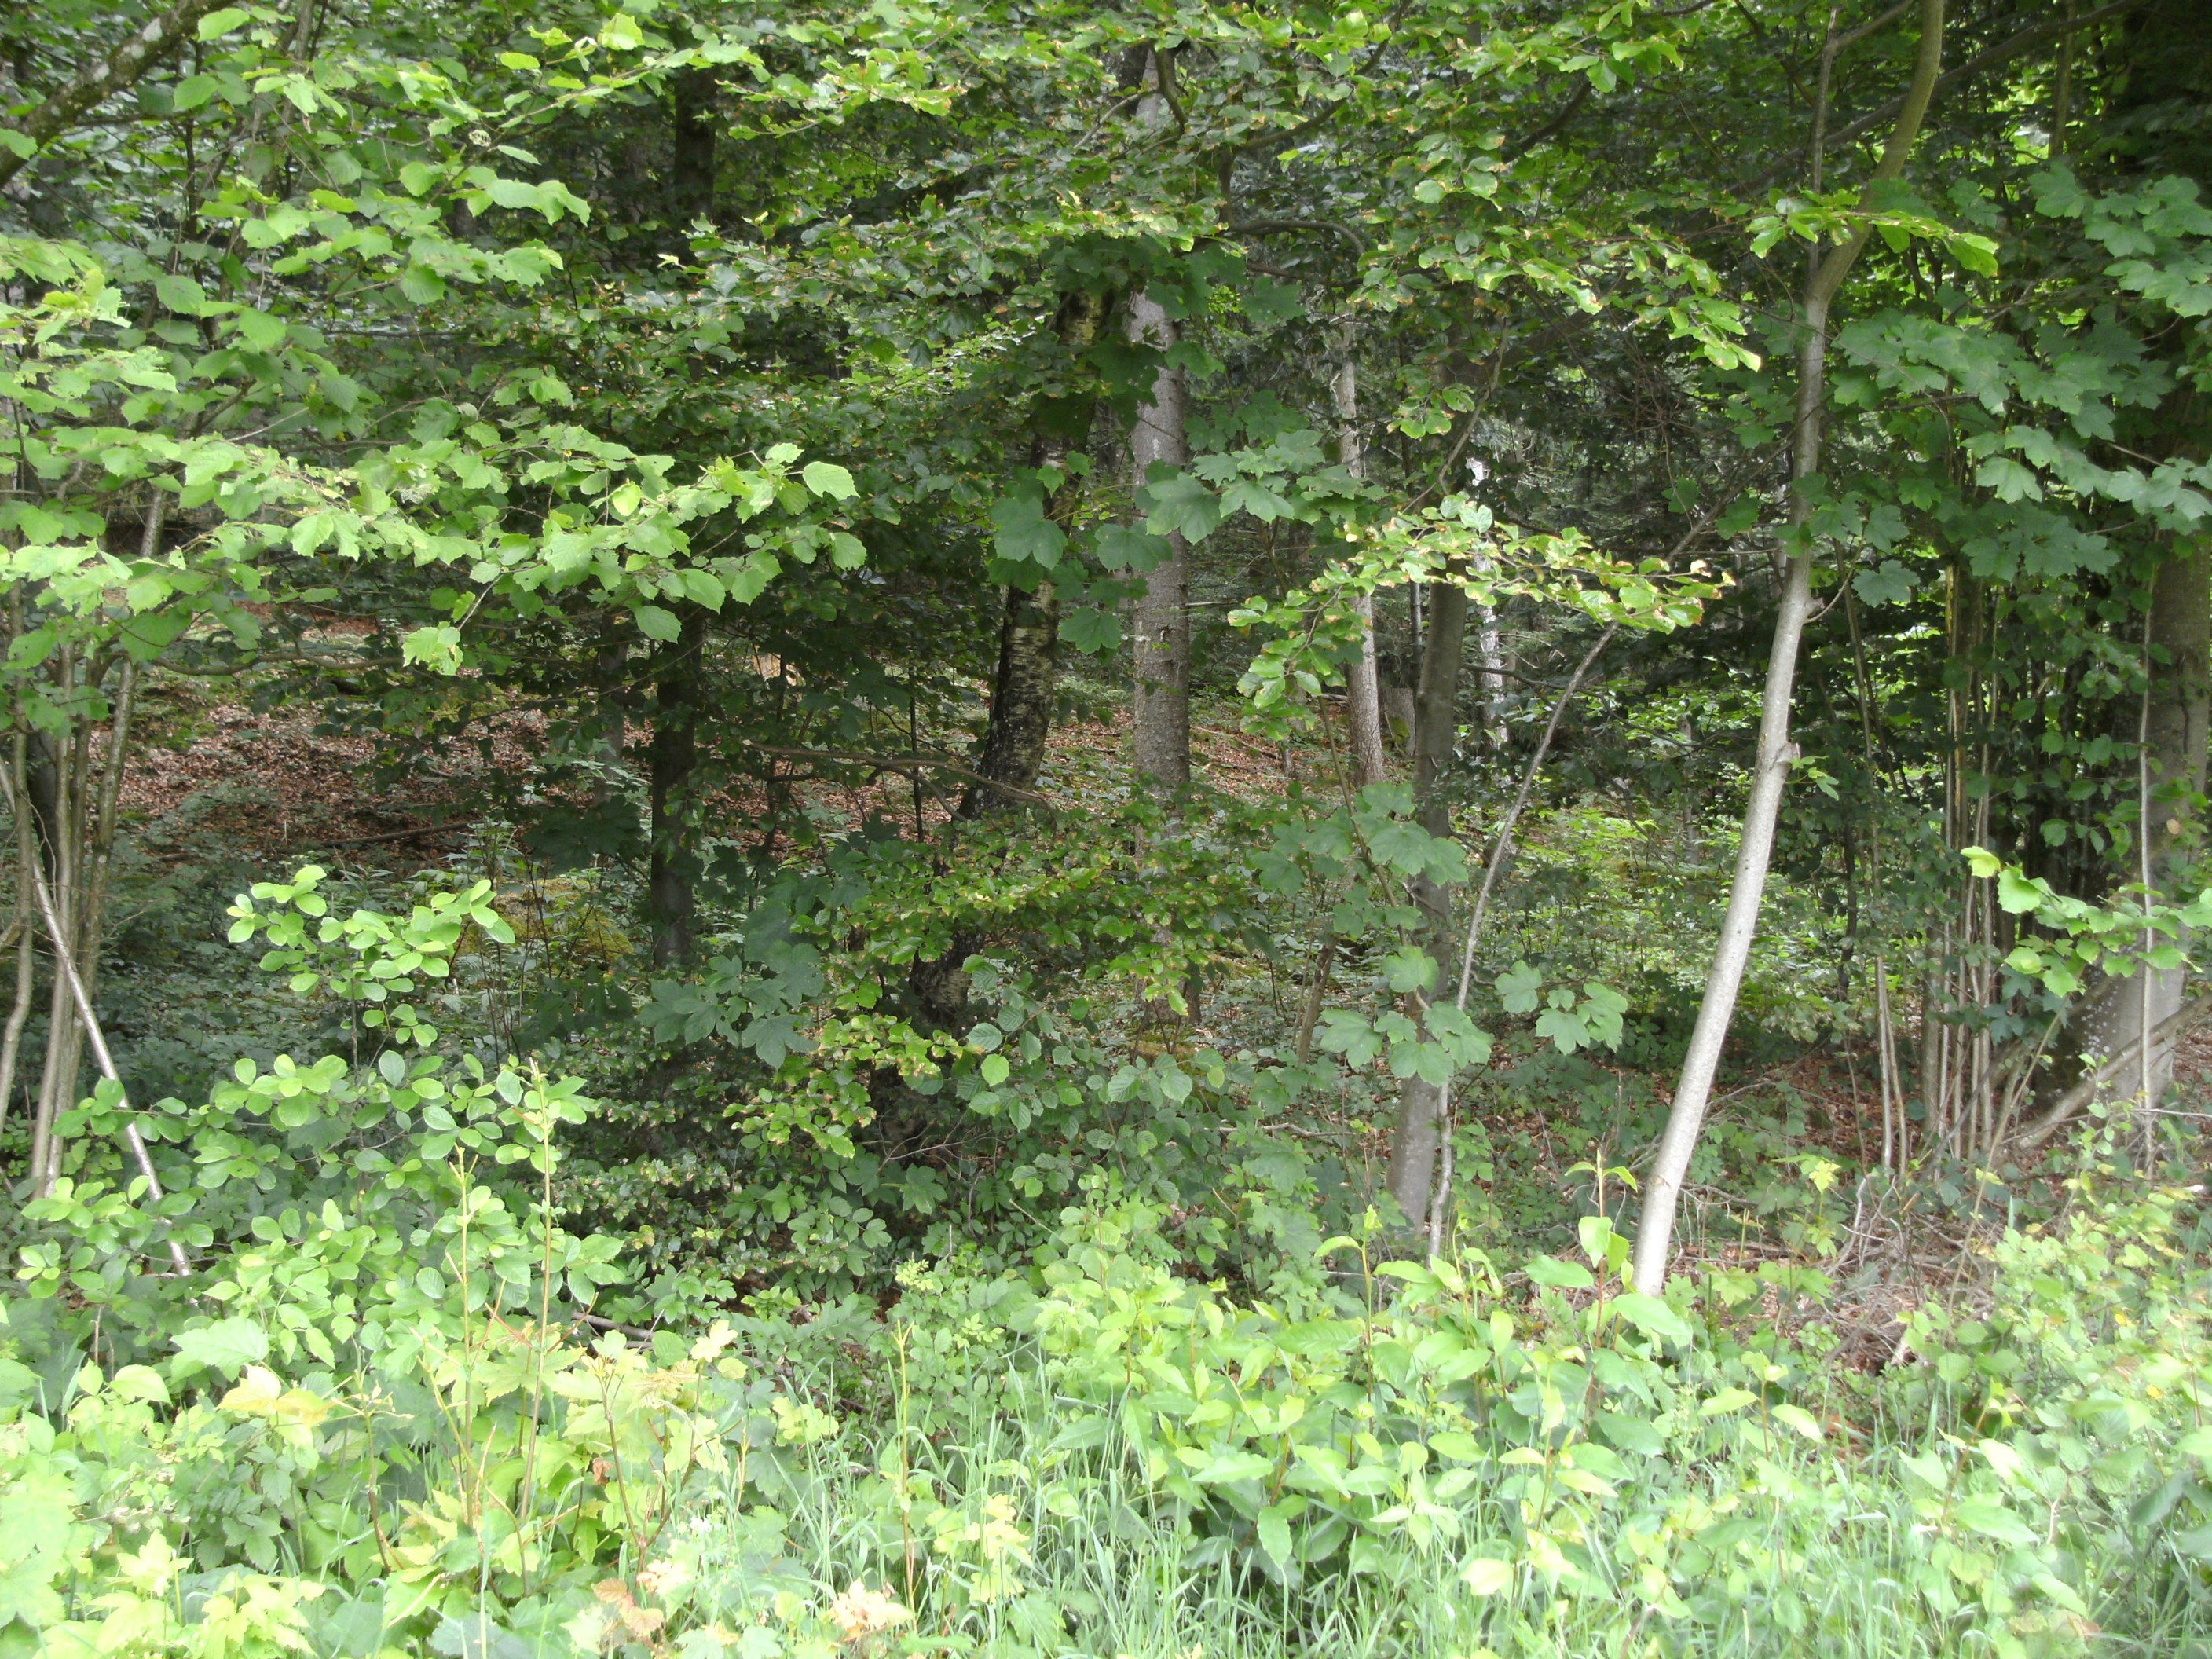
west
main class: Cropland
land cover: Temporary grasslands
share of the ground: > 75 %
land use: Agriculture (excluding fallow land and kitchen gardens)
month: June
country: AT
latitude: 48.6421
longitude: 13.8679
